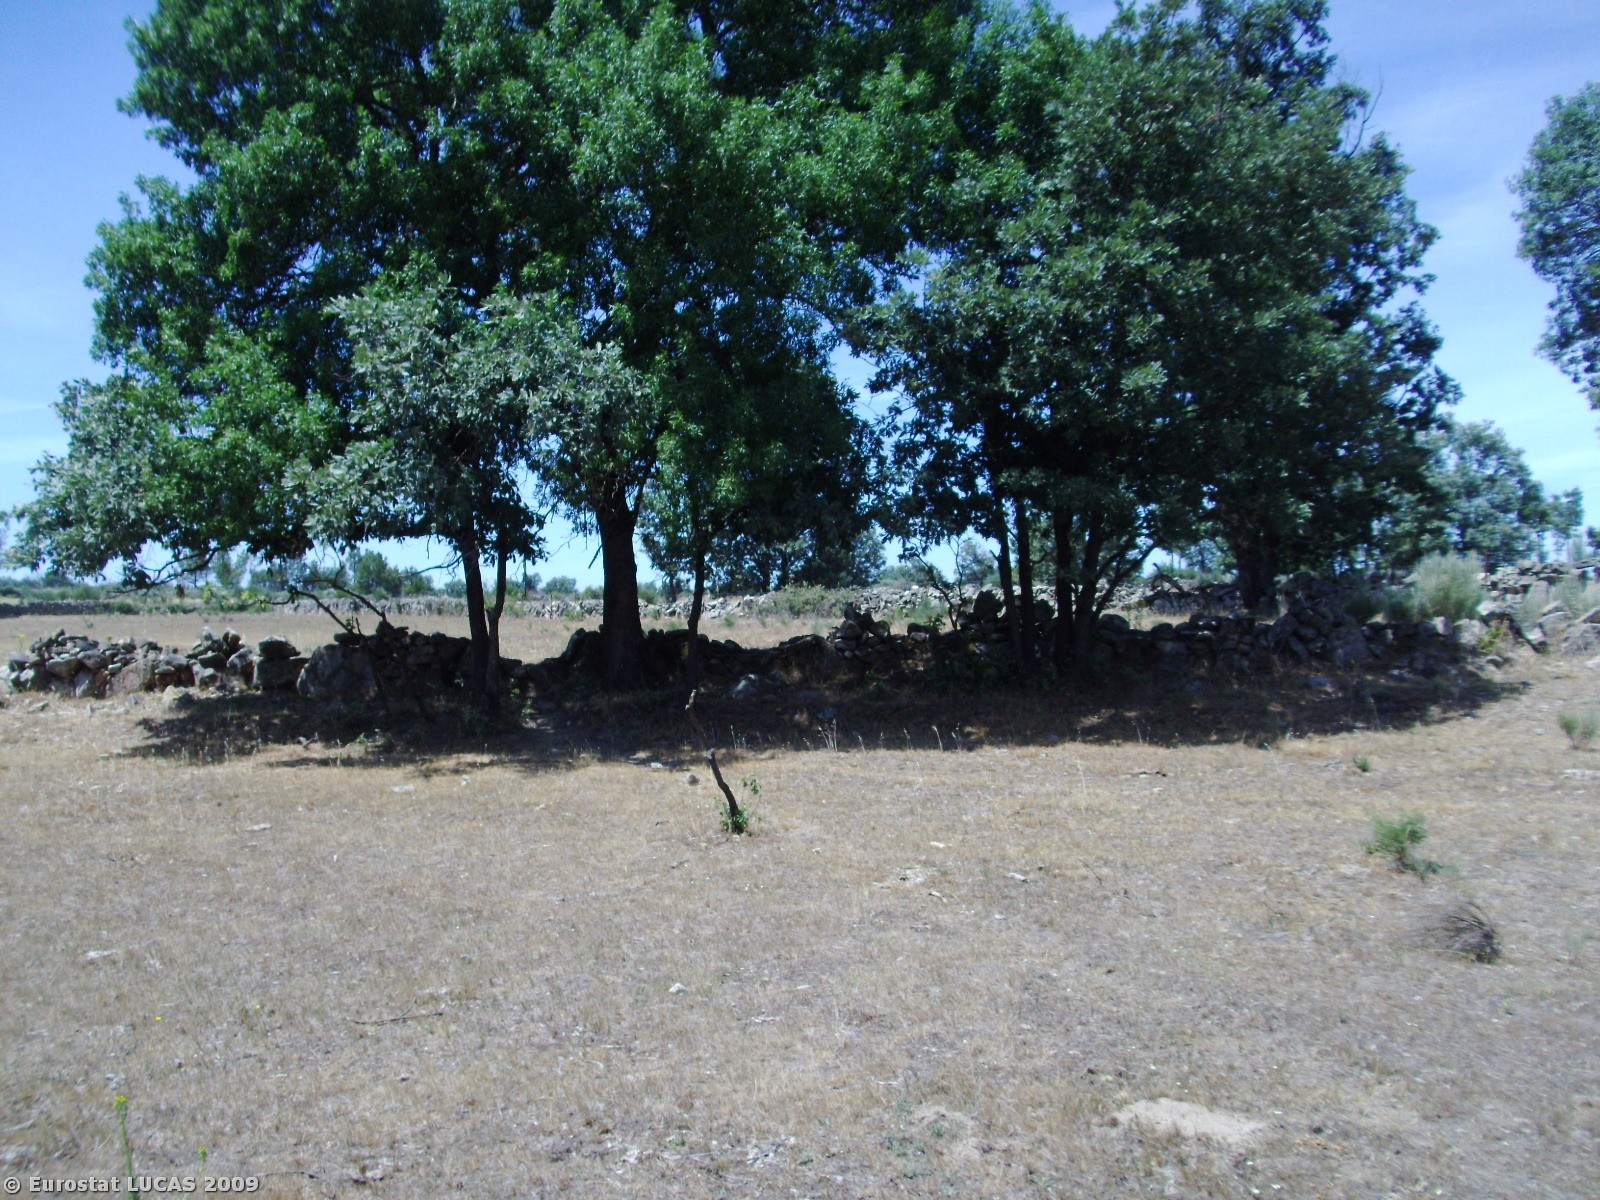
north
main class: Grassland
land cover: Spontaneously vegetated surfaces
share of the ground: > 75 %
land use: Fallow land
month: July
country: PT
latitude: 40.4149
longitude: -6.9848
